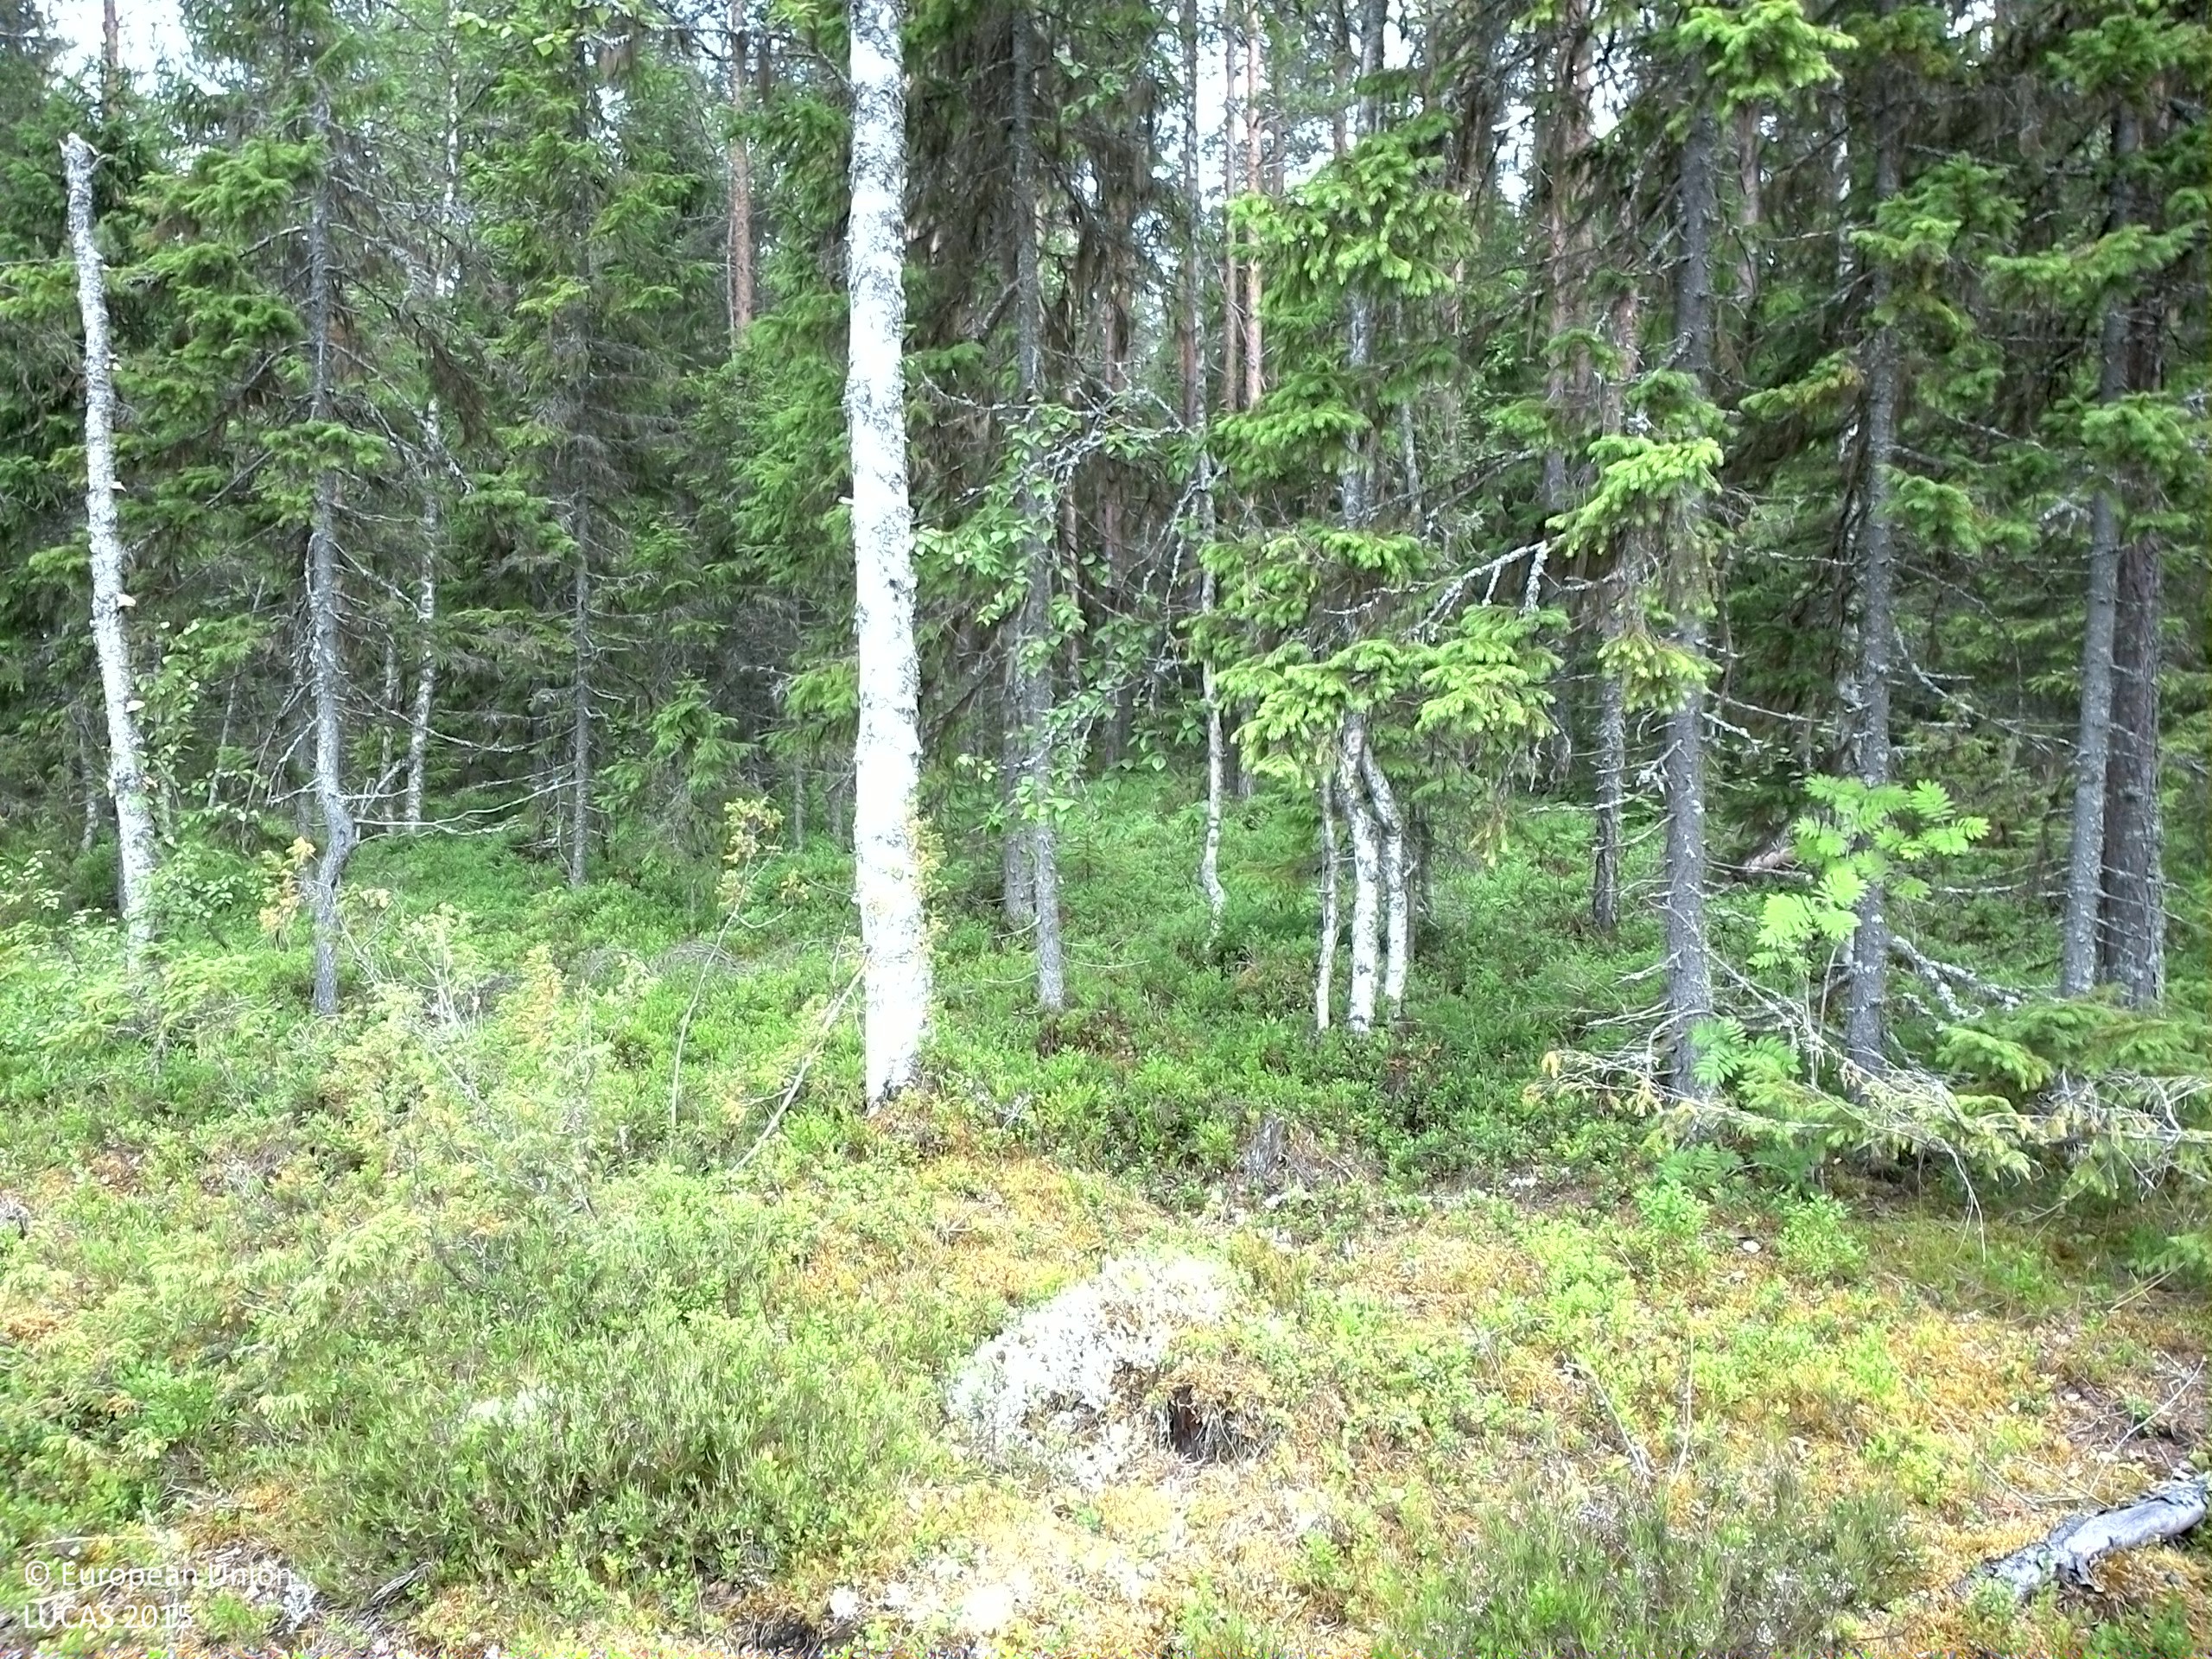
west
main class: Woodland
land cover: Pine dominated mixed woodland
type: boreal forest
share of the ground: 50 - 75 %
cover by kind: coniferous forest trees 35 %, shrubs 30 %, broadleaved forest trees 25 %, herbaceous plants 5 %, lichens and mosses 5 %
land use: Forestry
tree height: > 5 m
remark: Clear cut
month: July
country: SE
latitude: 63.5328
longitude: 18.5230
